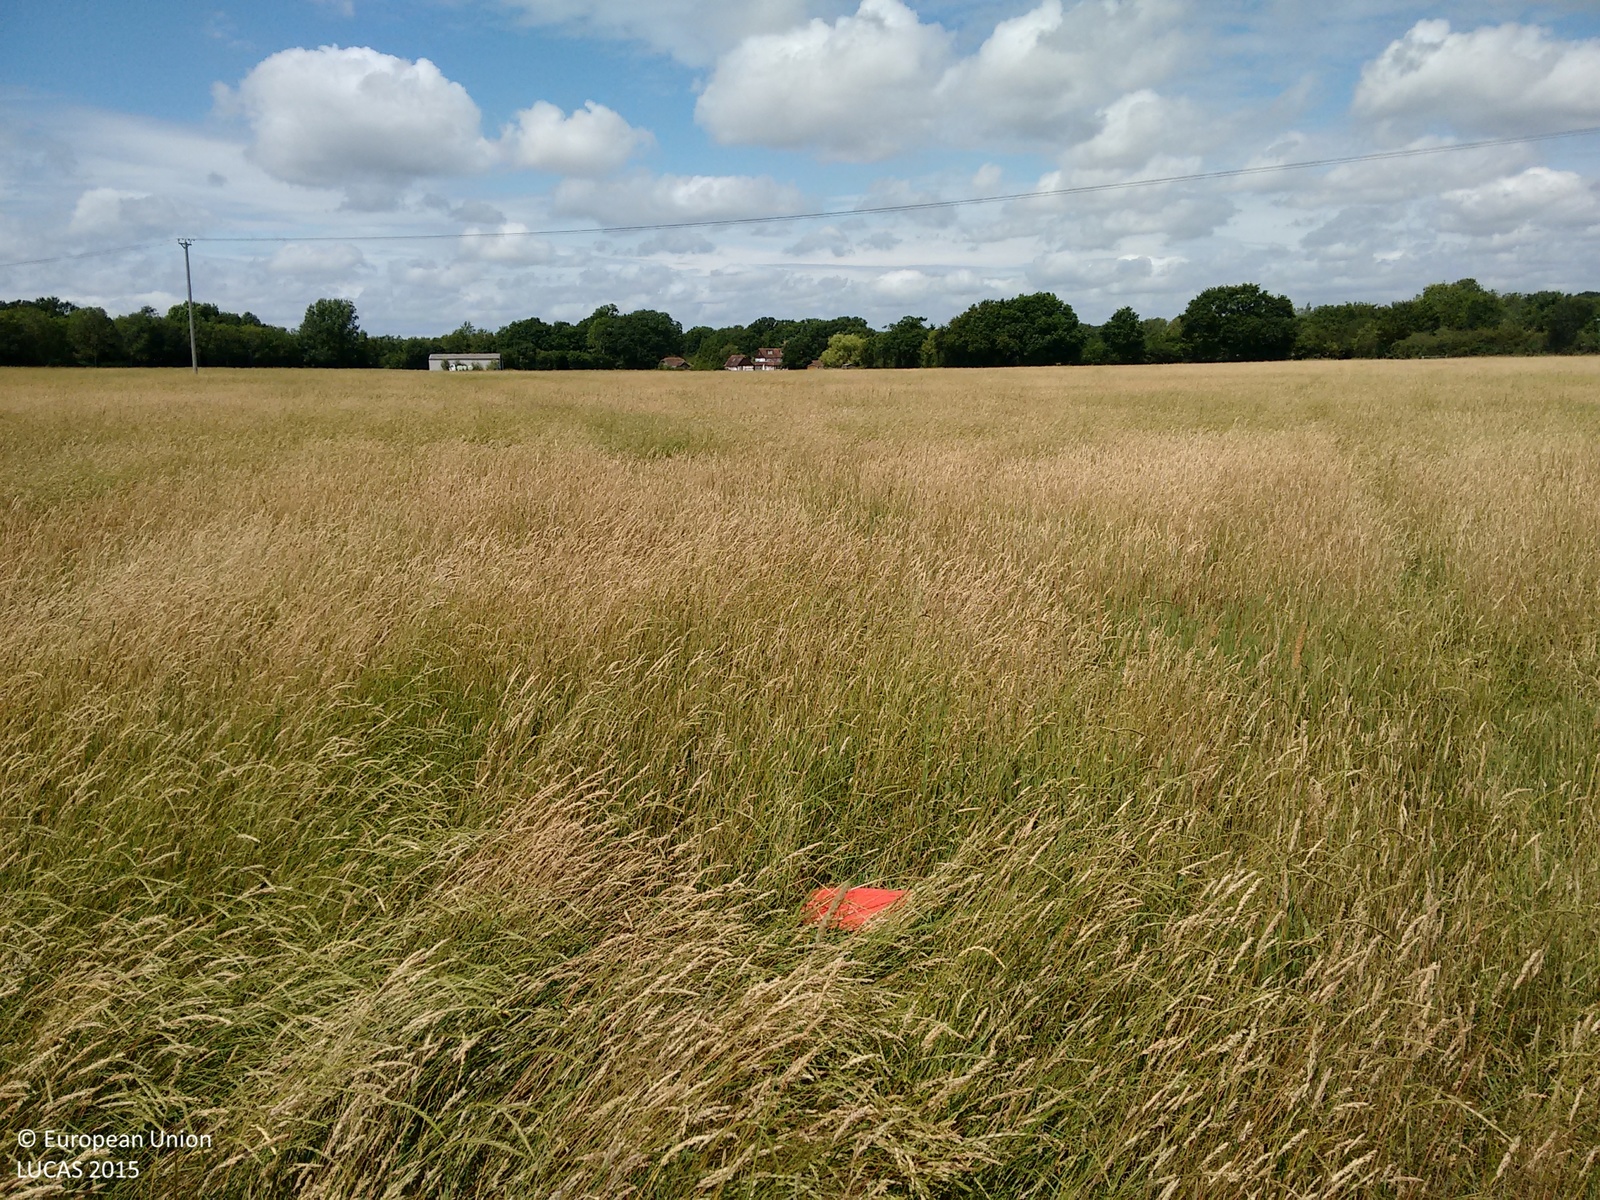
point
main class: Grassland
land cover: Grassland without tree/shrub cover
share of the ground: > 75 %
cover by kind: herbaceous plants 100 %
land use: Agriculture (excluding fallow land and kitchen gardens)
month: July
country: GB
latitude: 51.0103
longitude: -0.4278
